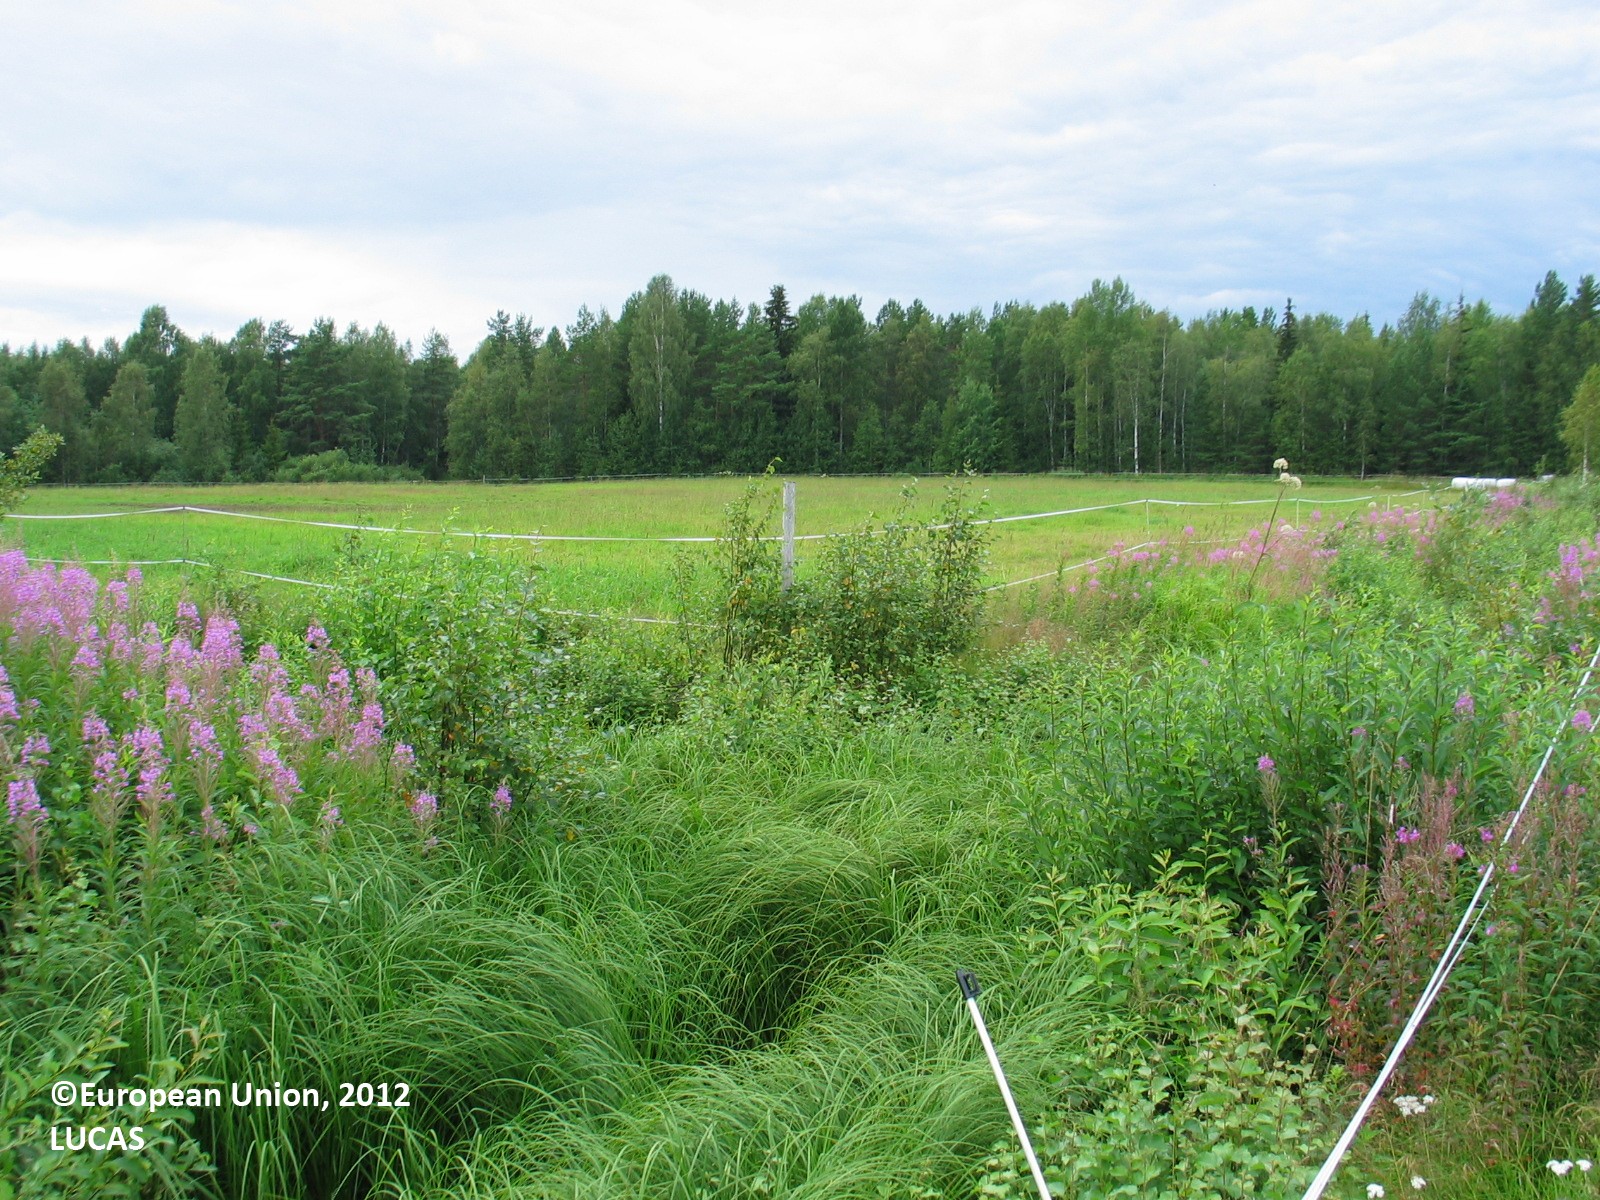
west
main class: Grassland
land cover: Grassland without tree/shrub cover
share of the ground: > 75 %
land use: Agriculture (excluding fallow land and kitchen gardens)
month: July
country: FI
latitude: 64.7676
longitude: 26.1435
